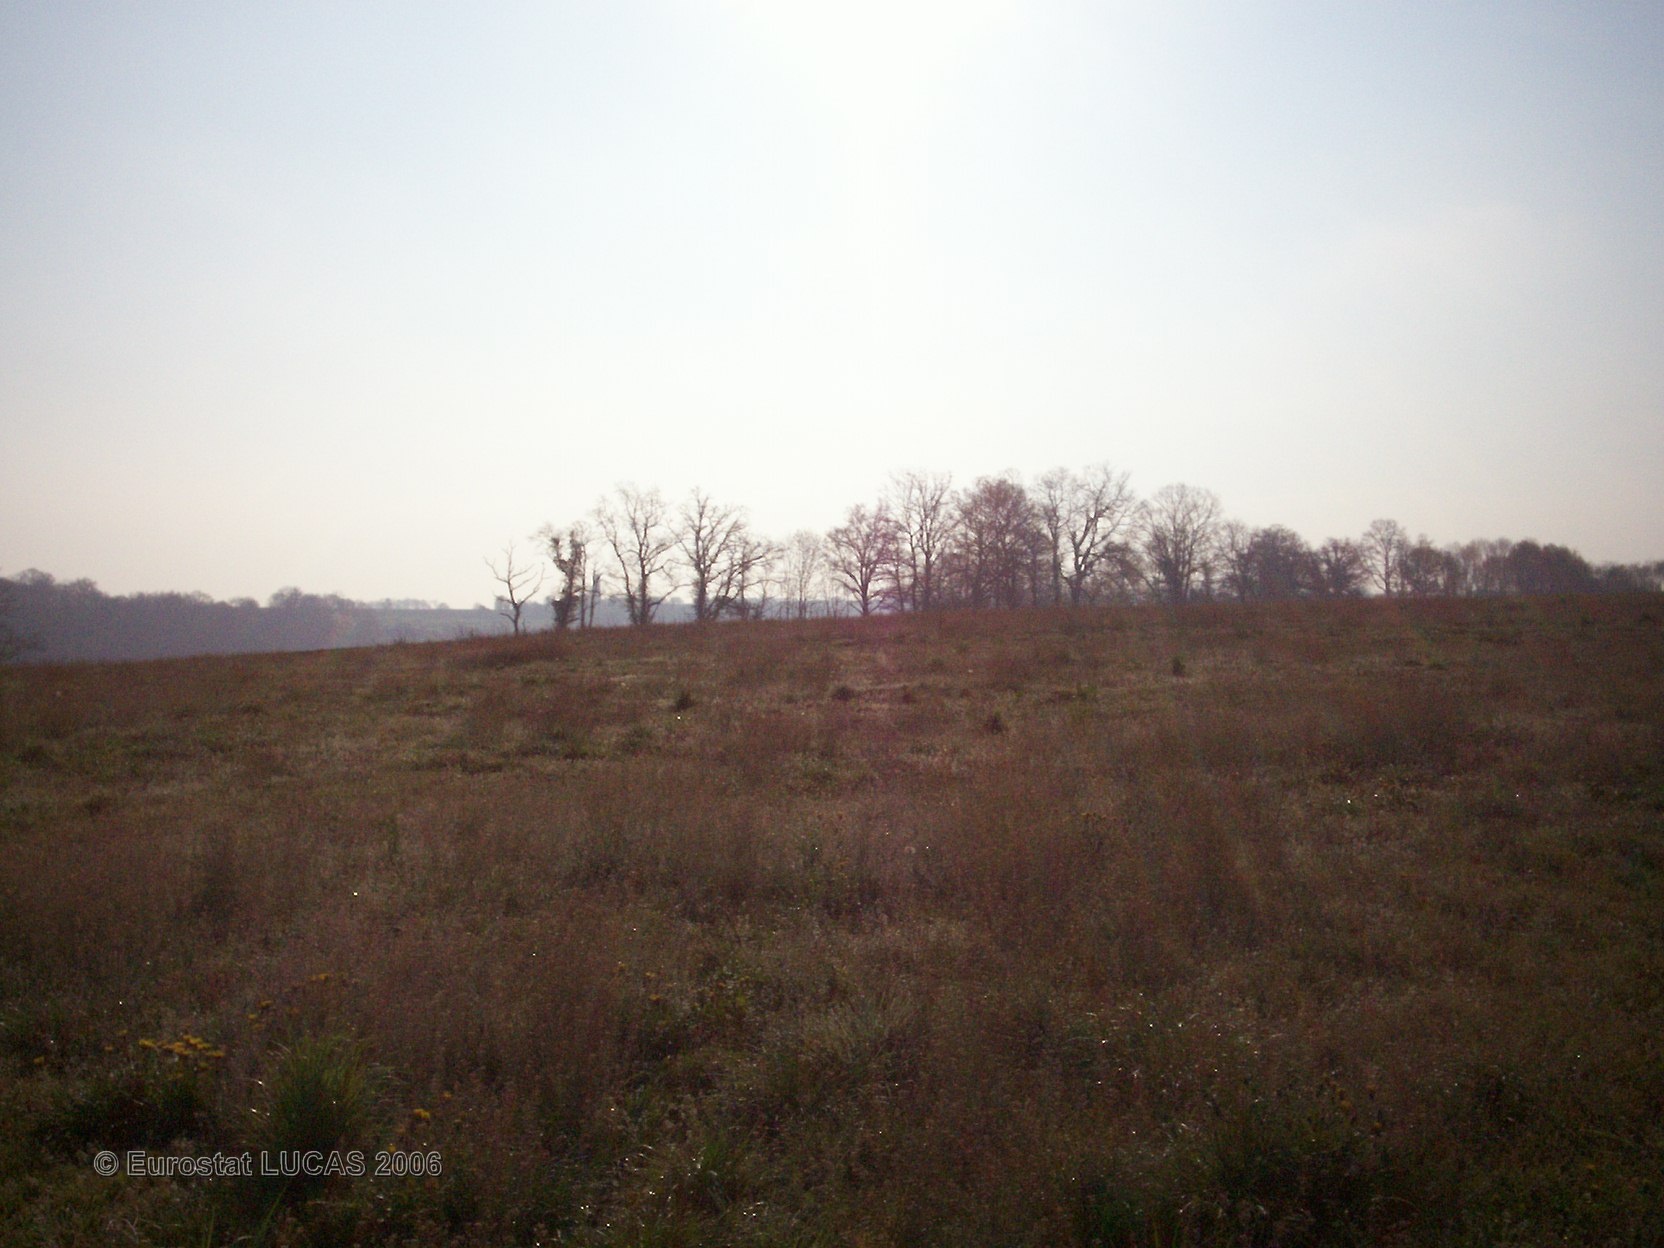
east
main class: Grassland
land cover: Grassland without tree/shrub cover
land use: Fallow land
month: April
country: FR
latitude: 43.2885
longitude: -0.1481
